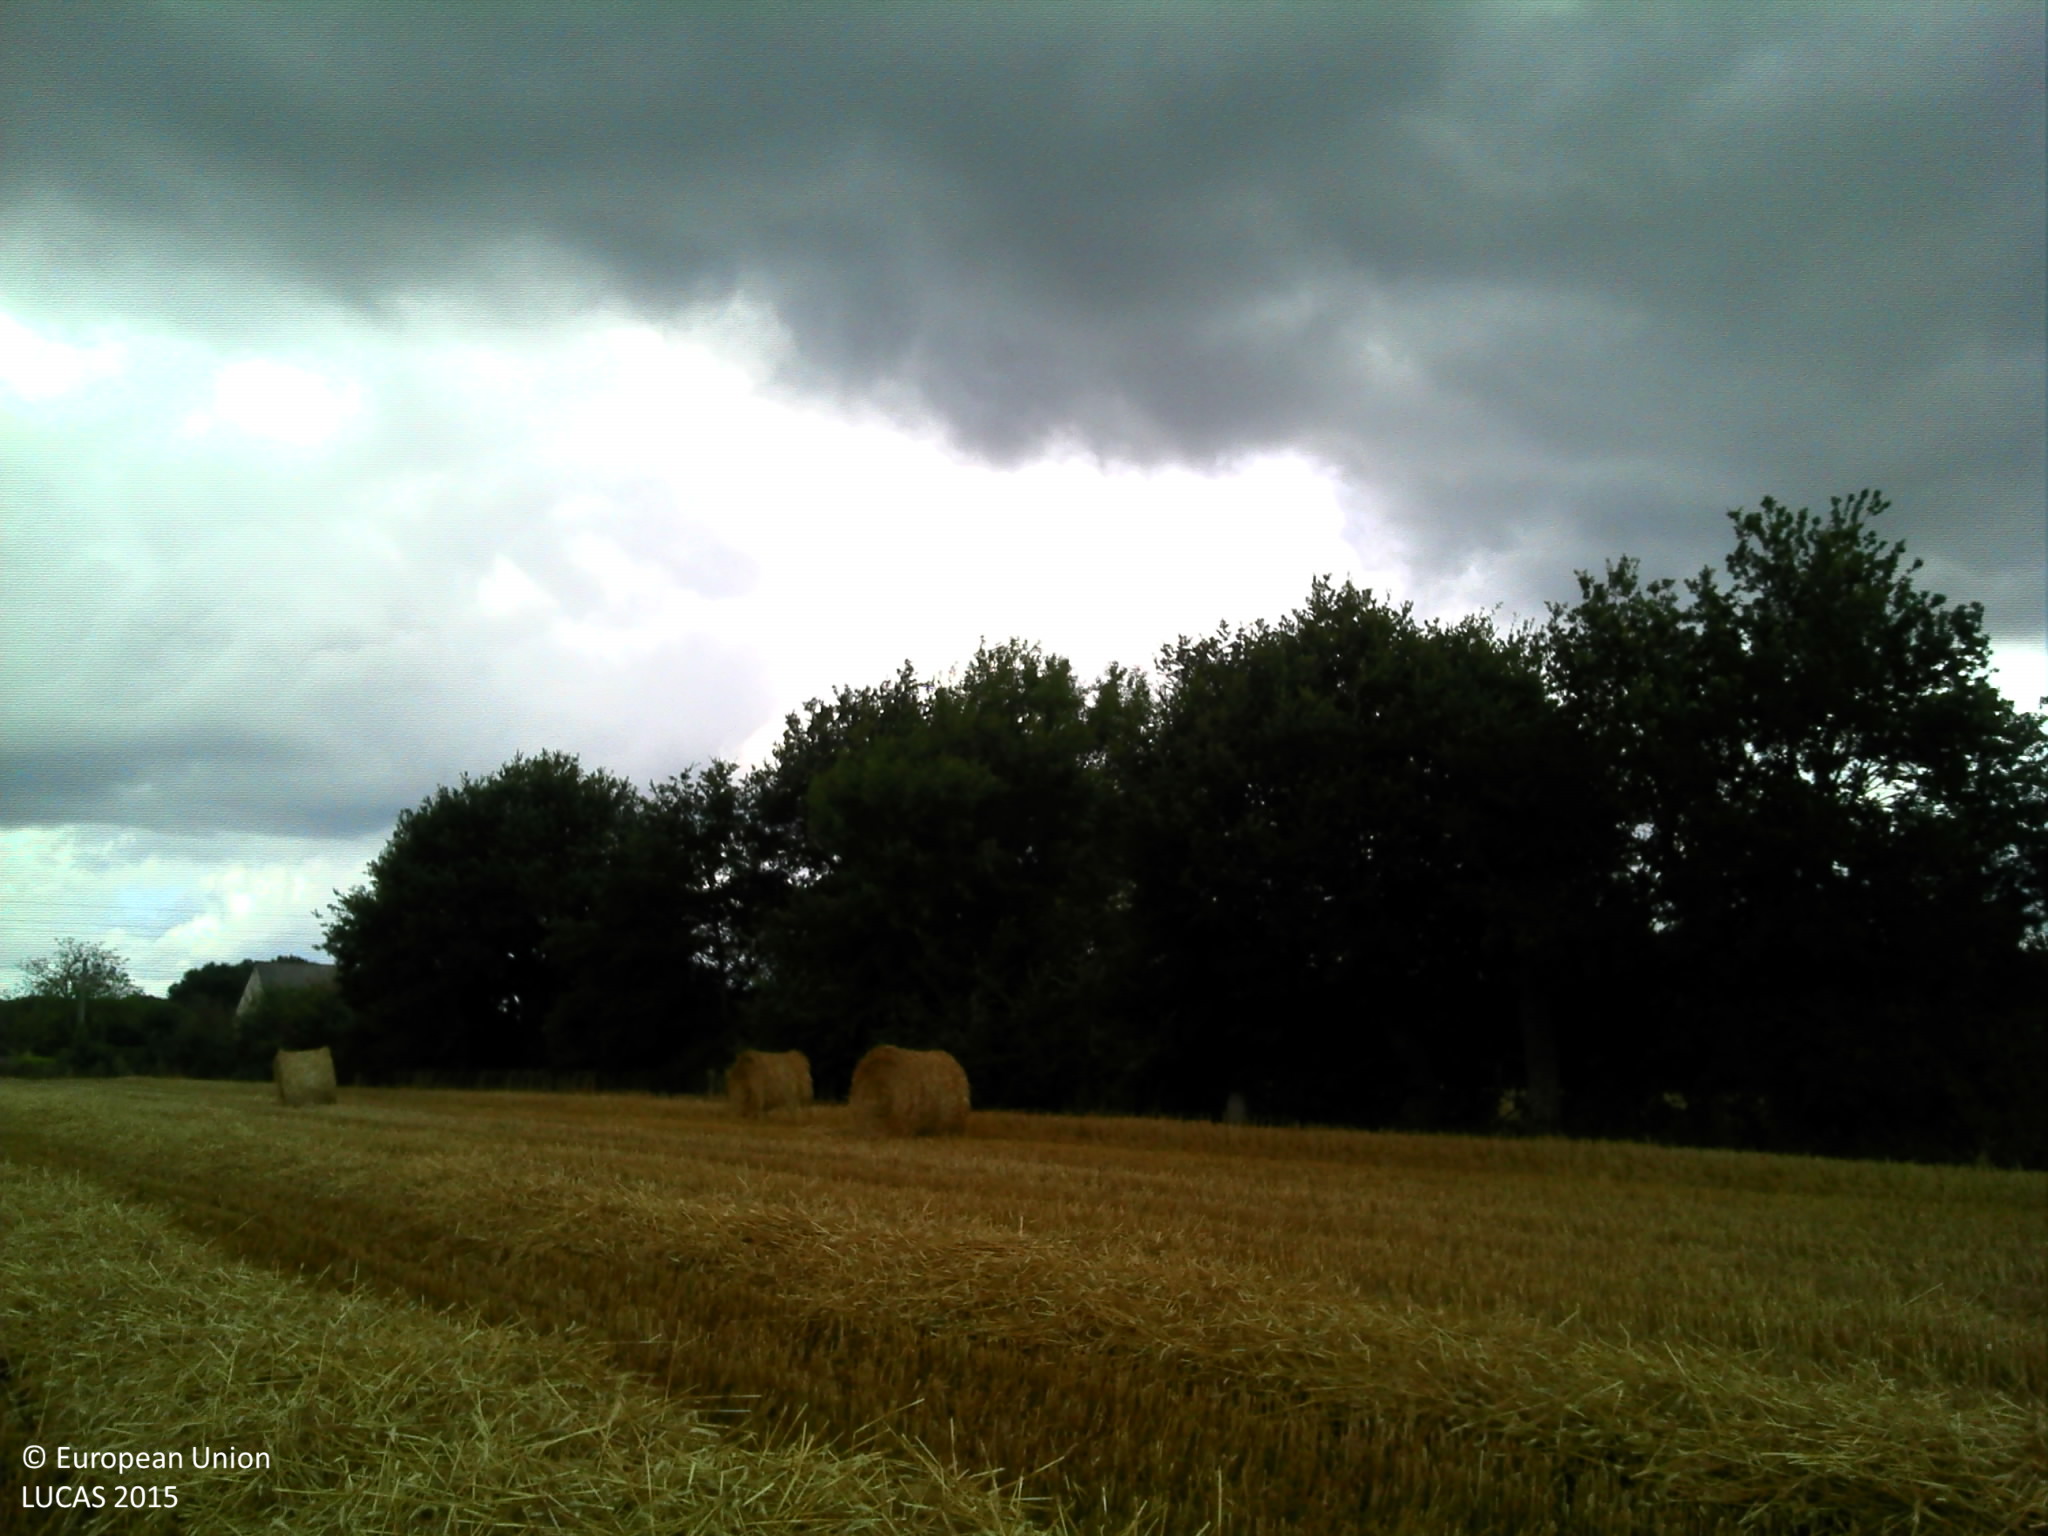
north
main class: Cropland
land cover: Triticale
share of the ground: > 75 %
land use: Agriculture (excluding fallow land and kitchen gardens)
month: July
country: FR
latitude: 47.7542
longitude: 0.2508
